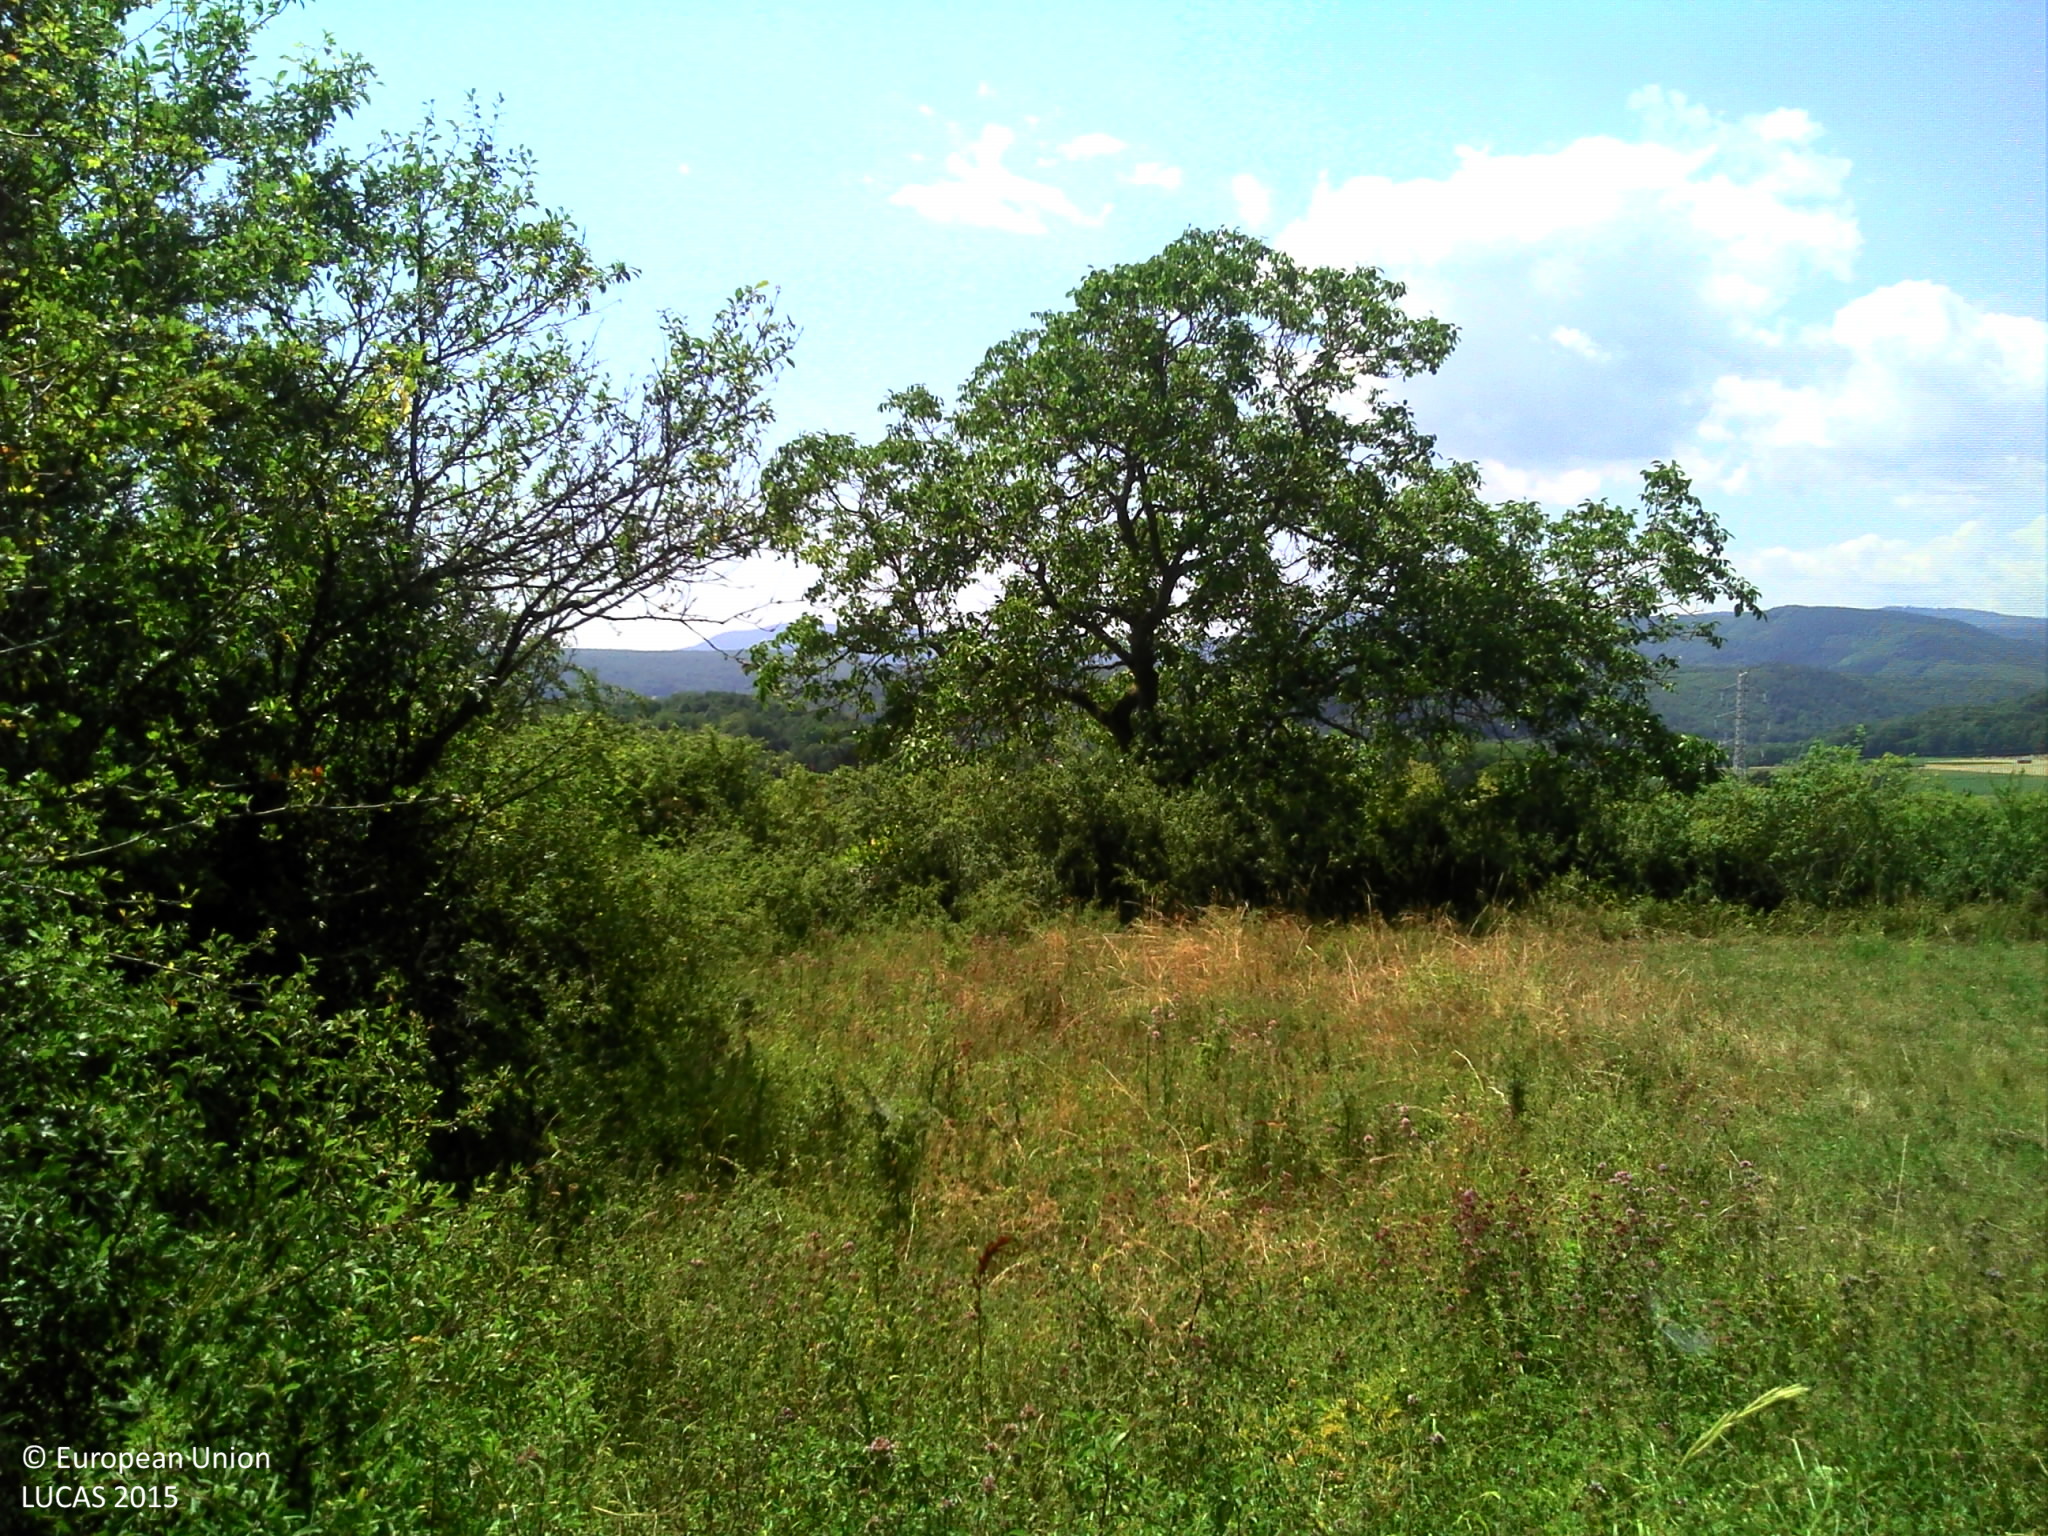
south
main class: Woodland
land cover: Broadleaved woodland
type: mesophytic deciduous forest
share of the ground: > 75 %
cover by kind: broadleaved forest trees 75 %, herbaceous plants 25 %
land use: Agriculture (excluding fallow land and kitchen gardens)
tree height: > 5 m
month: July
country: FR
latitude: 48.5533
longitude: 7.4132
